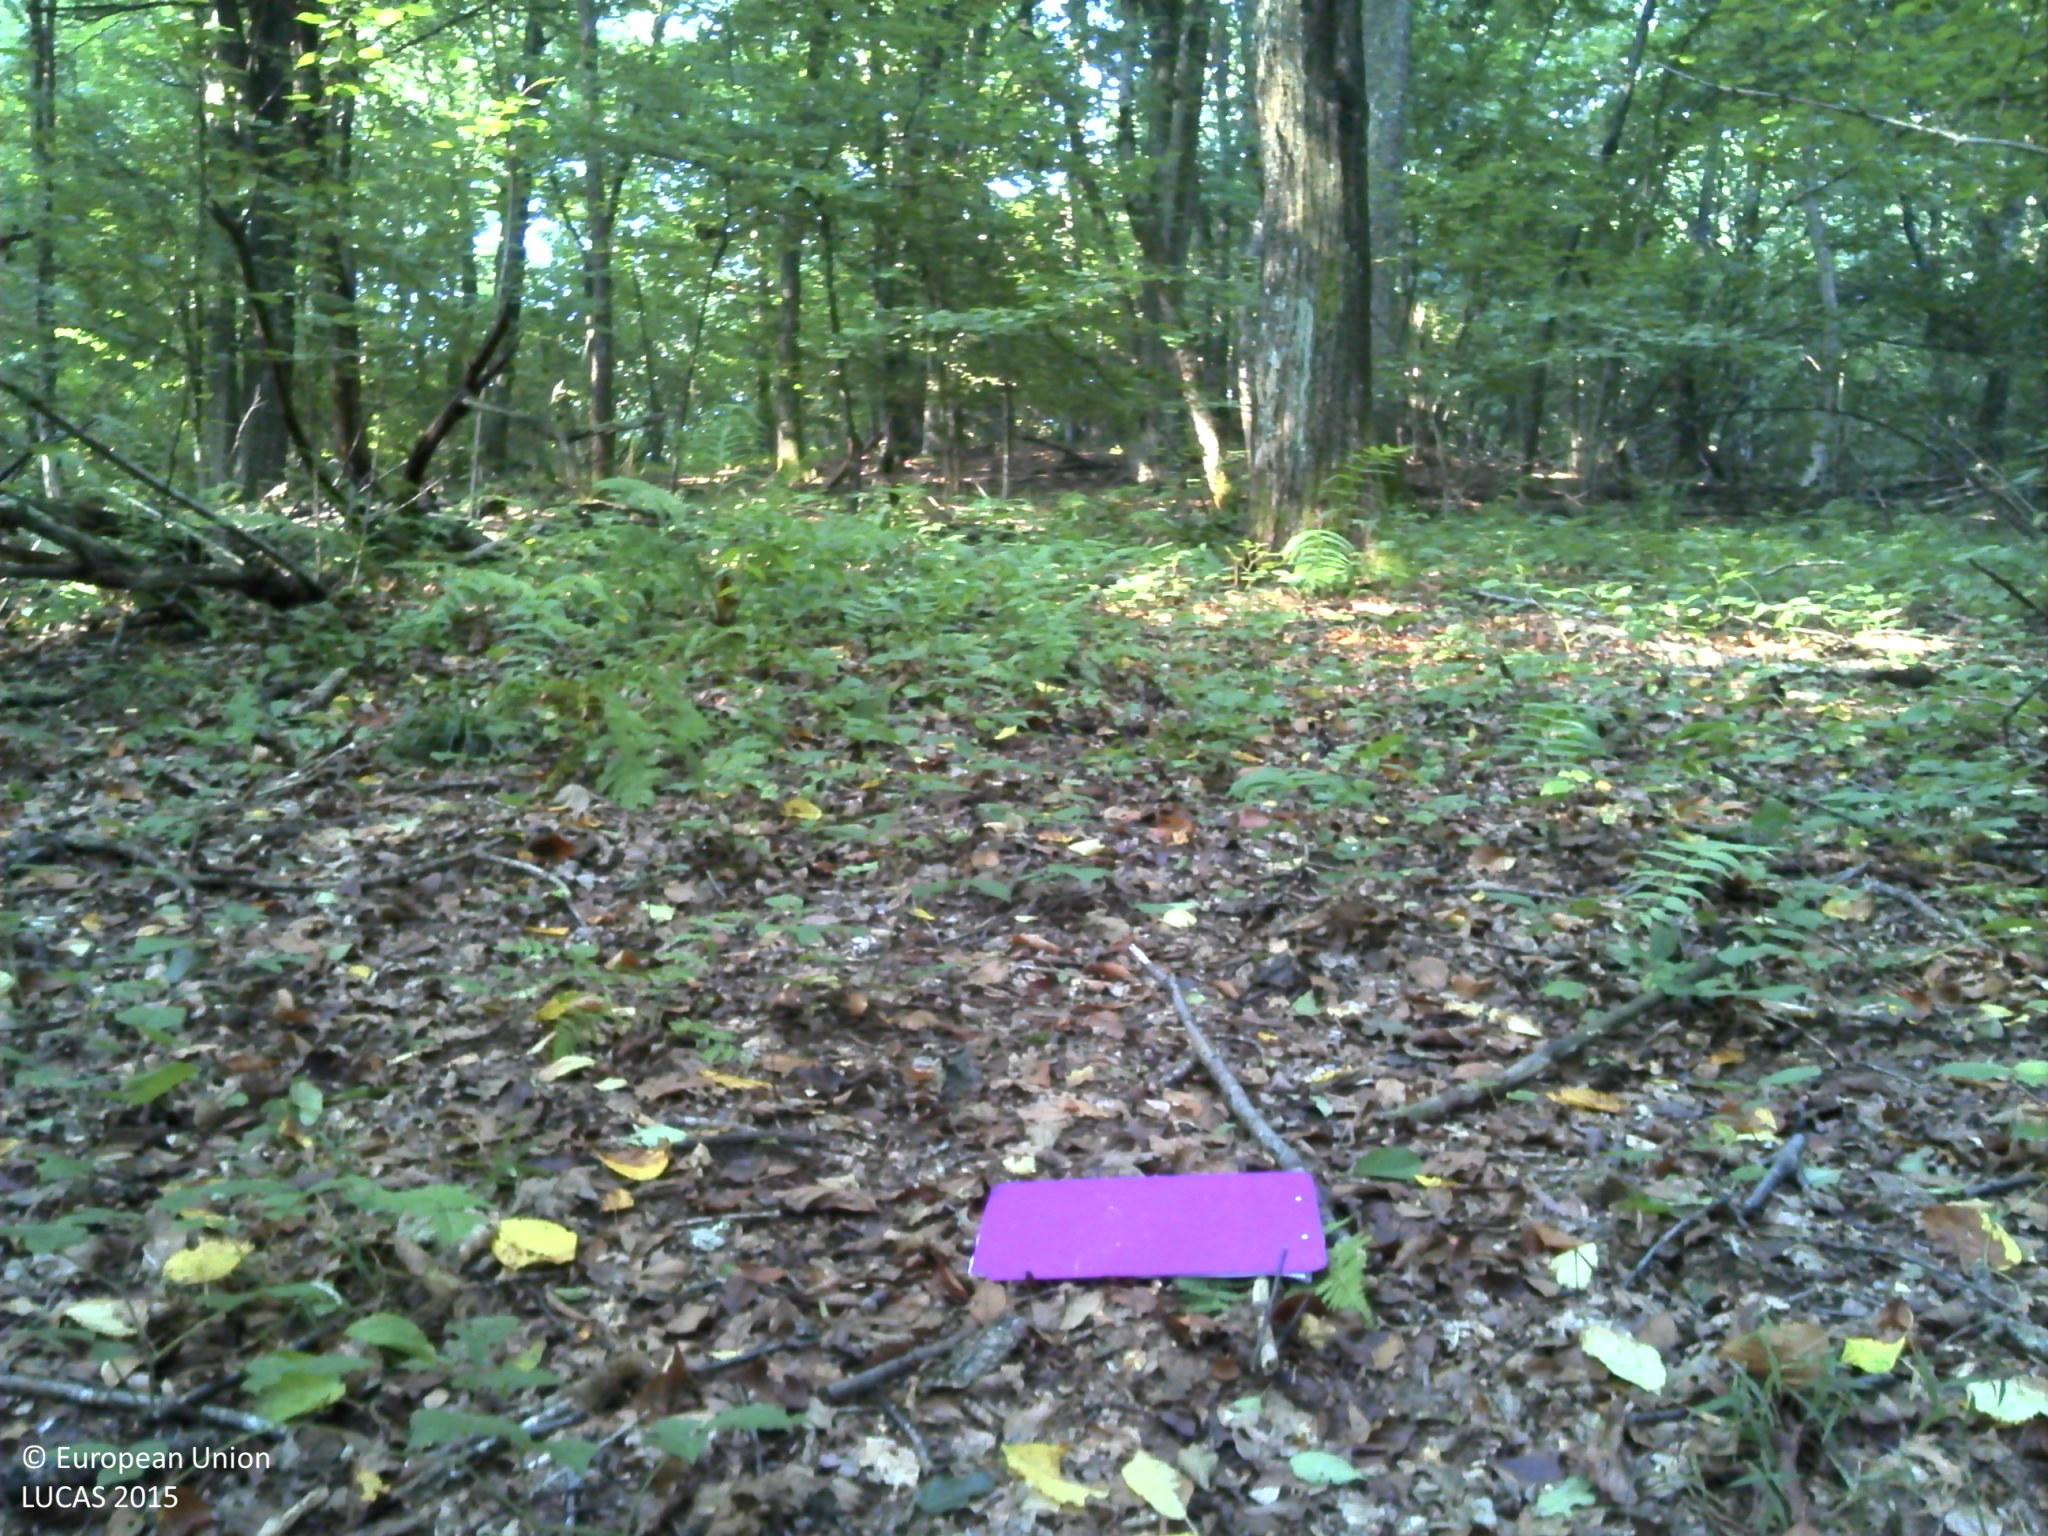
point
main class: Woodland
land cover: Broadleaved woodland
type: beech forest
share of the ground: > 75 %
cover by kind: broadleaved forest trees 100 %
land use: Forestry
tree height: > 5 m
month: August
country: HR
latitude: 45.3440
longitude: 16.1356
